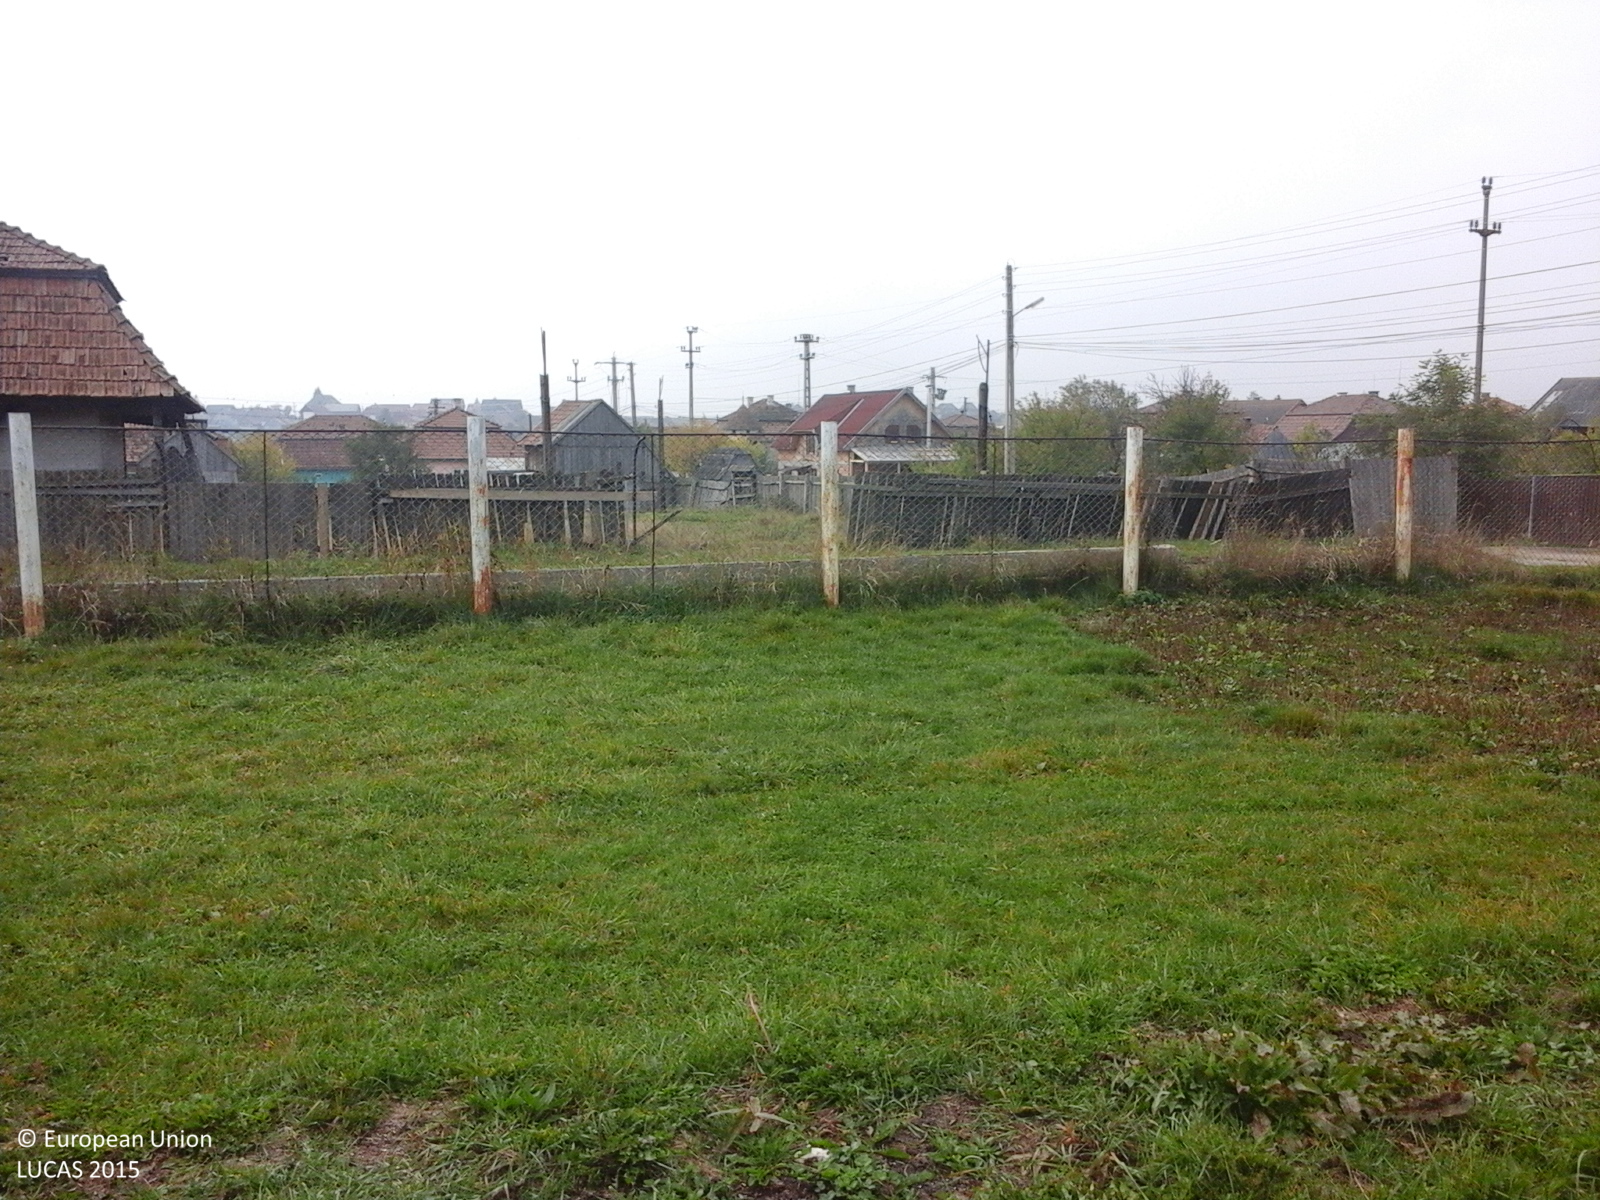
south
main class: Grassland
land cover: Grassland without tree/shrub cover
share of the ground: > 75 %
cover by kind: herbaceous plants 100 %
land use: Agriculture (excluding fallow land and kitchen gardens)
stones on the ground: < 10 %
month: October
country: RO
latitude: 46.7957
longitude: 25.4516
